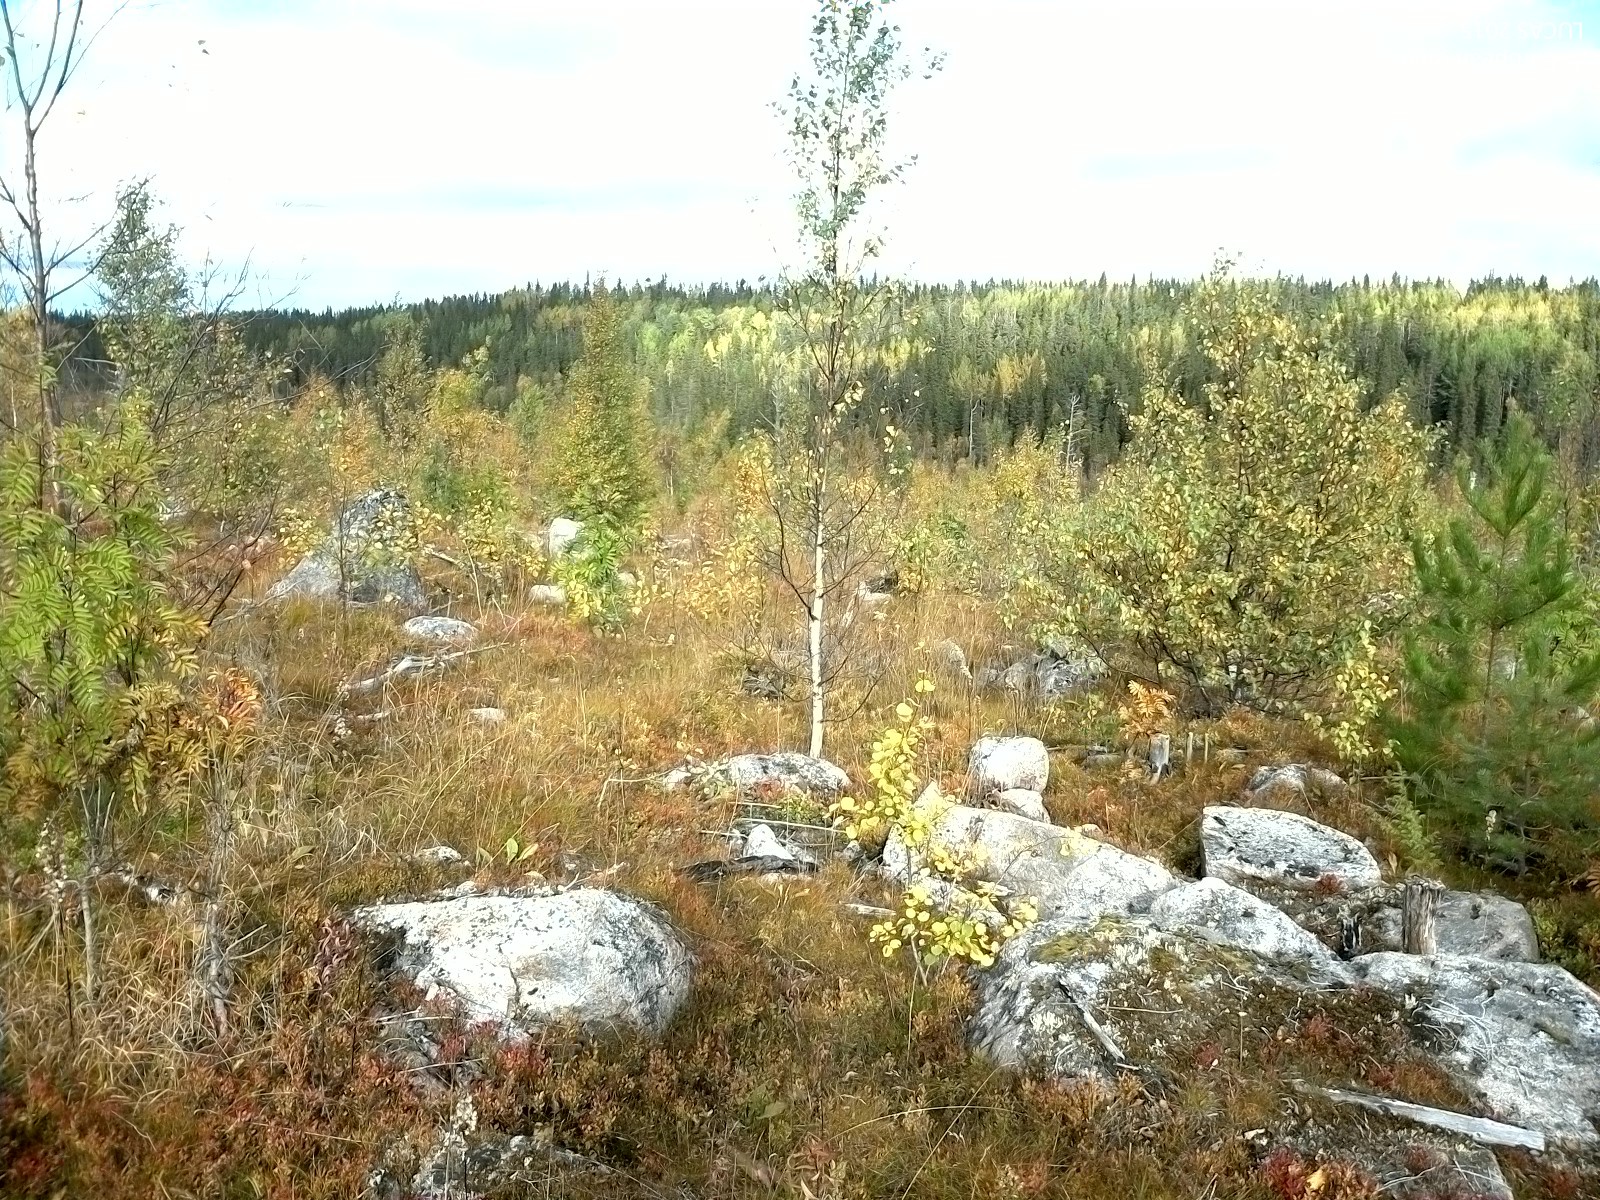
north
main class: Woodland
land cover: Broadleaved woodland
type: boreal forest
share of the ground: 25 - 50 %
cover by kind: herbaceous plants 55 %, broadleaved forest trees 25 %, shrubs 20 %
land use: Forestry
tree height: < 5 m
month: September
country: SE
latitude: 62.2480
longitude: 16.2368
